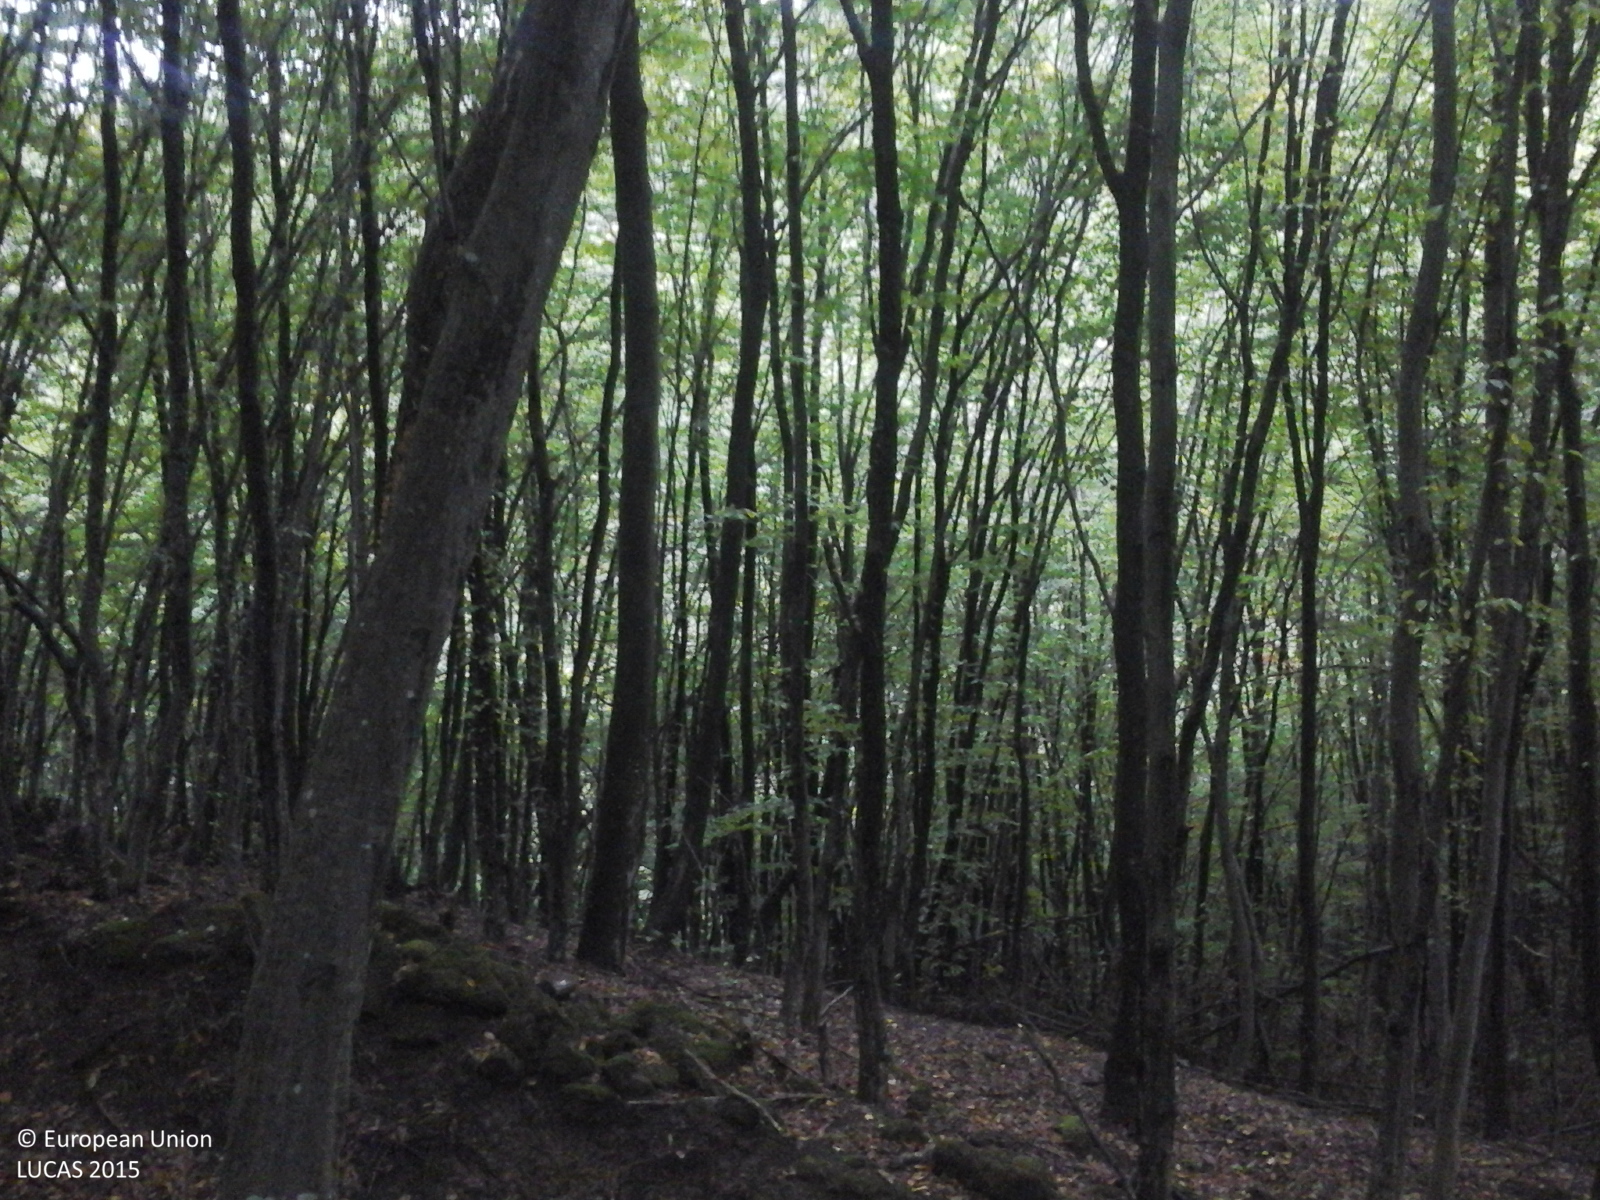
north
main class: Woodland
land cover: Broadleaved woodland
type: mesophytic deciduous forest
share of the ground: > 75 %
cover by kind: broadleaved forest trees 100 %
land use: Forestry
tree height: > 5 m
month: October
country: RO
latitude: 46.2516
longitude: 23.5441
